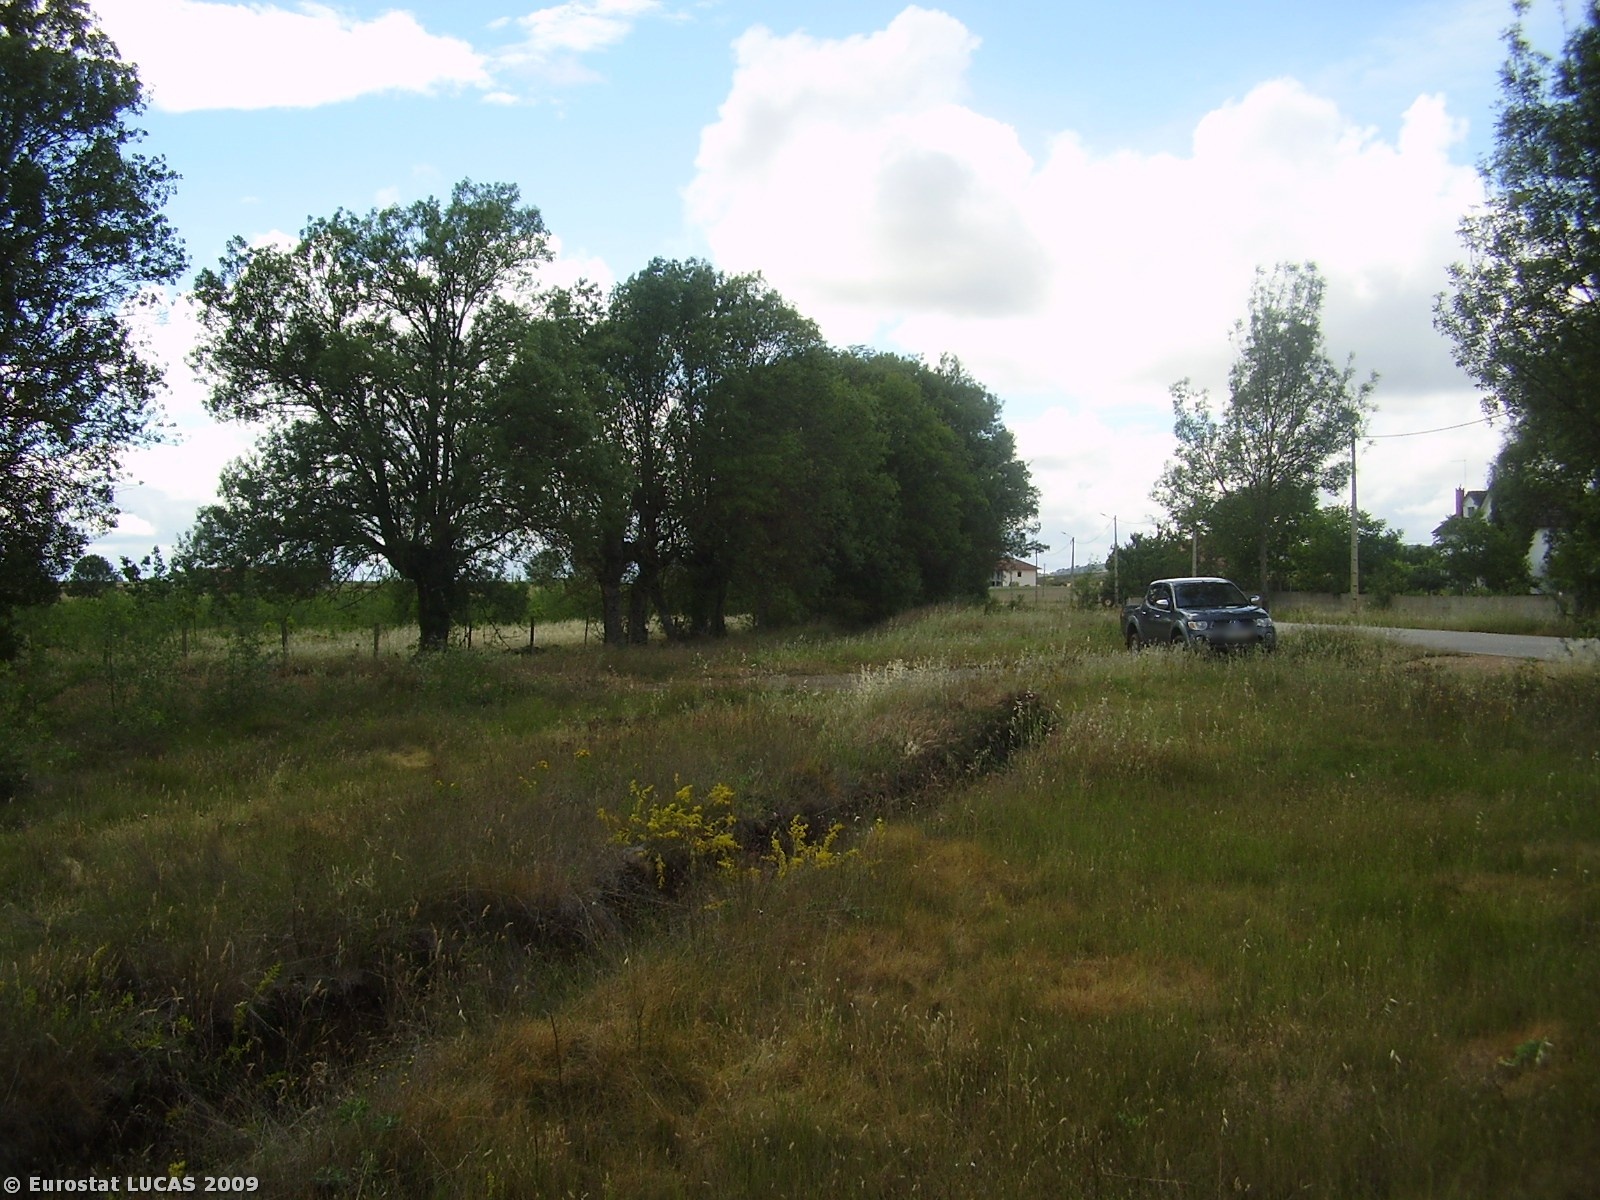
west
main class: Cropland
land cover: Temporary grasslands
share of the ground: > 75 %
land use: Agriculture (excluding fallow land and kitchen gardens)
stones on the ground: 10 - 25 %
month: June
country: PT
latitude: 41.5245
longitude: -6.8530
